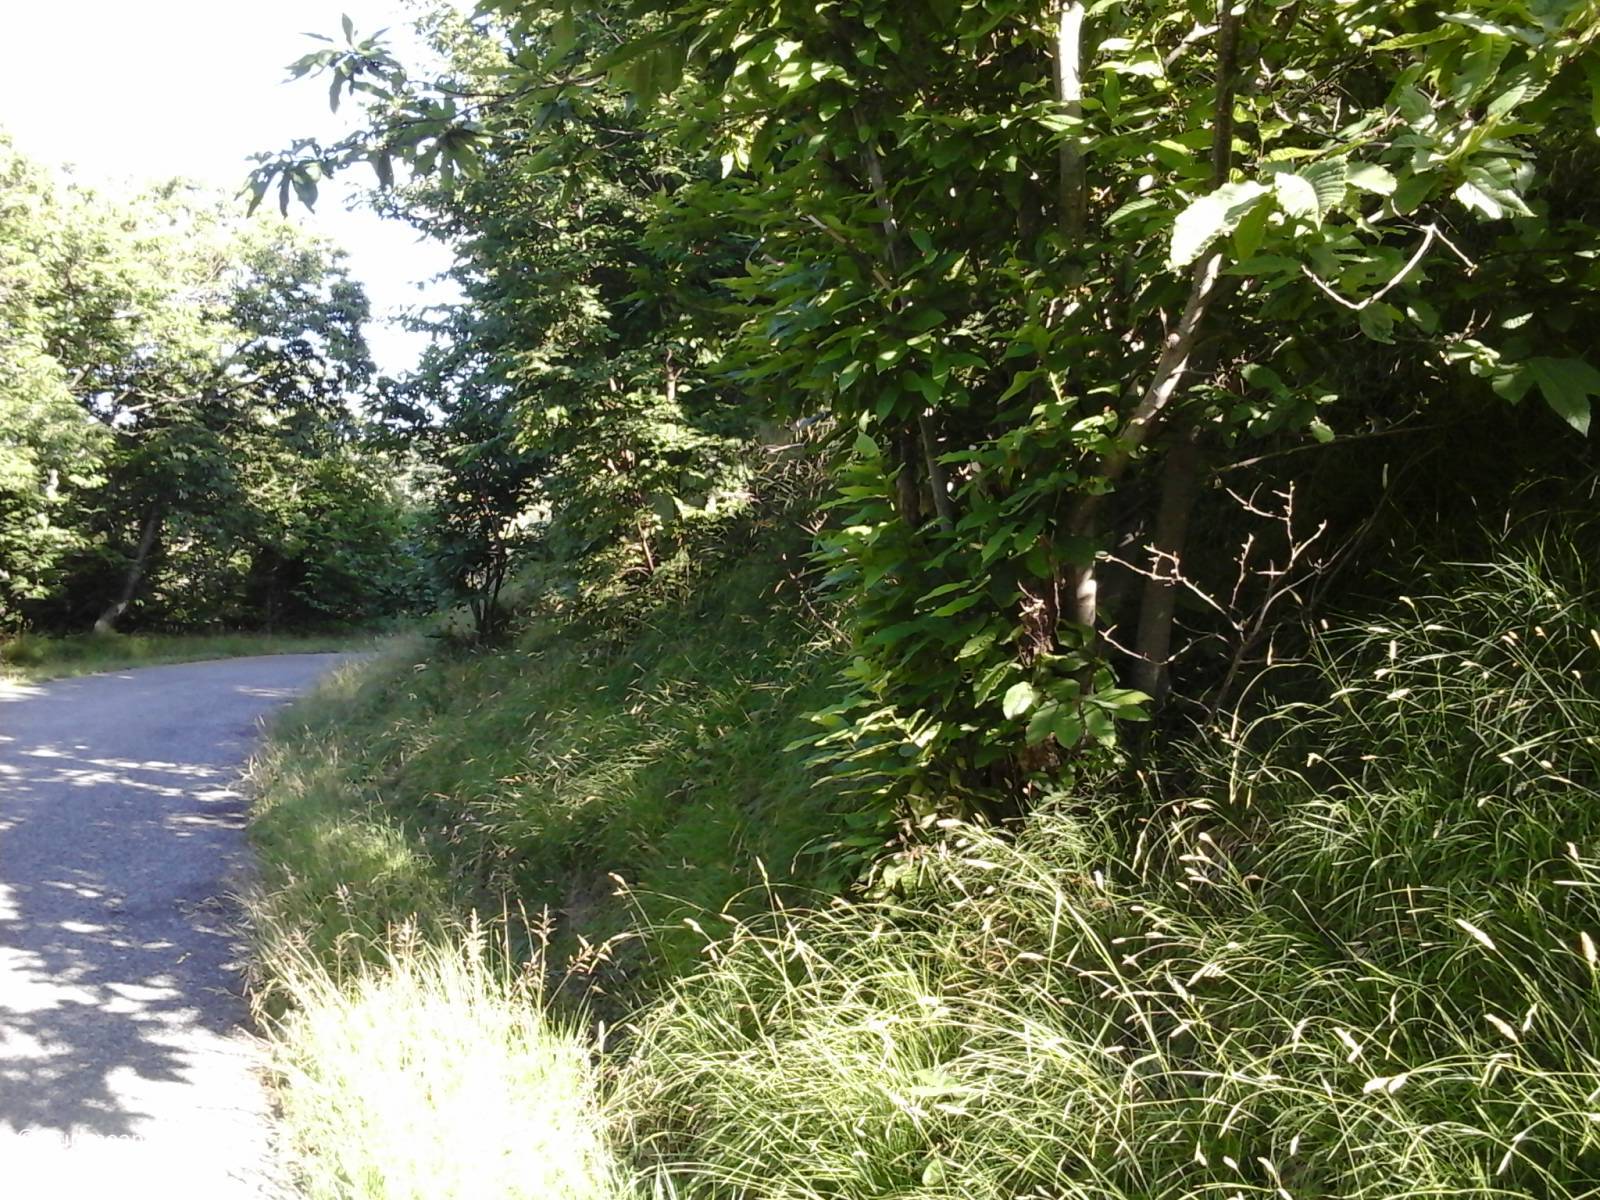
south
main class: Grassland
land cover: Grassland with sparse tree/shrub cover
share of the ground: > 75 %
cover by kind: herbaceous plants 85 %, shrubs 10 %, broadleaved forest trees 5 %
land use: Semi-natural and natural areas not in use
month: June
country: IT
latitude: 44.1700
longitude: 10.1871
